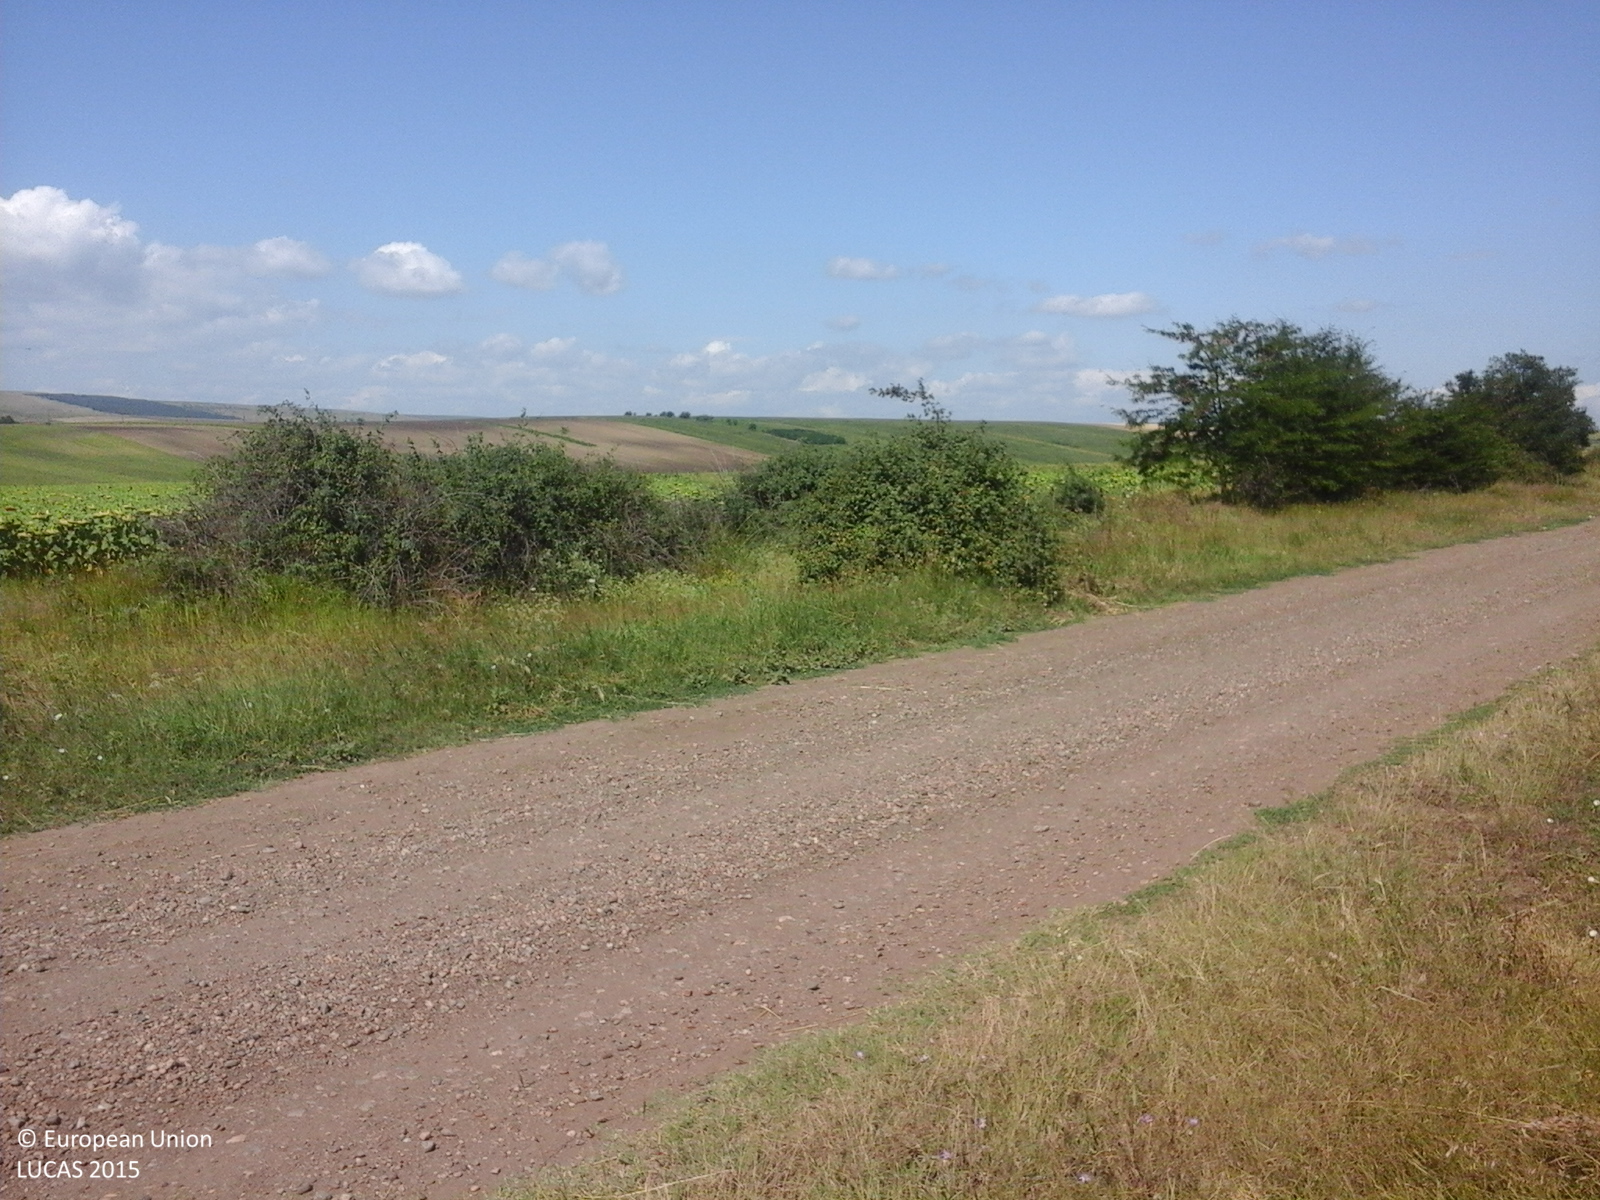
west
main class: Cropland
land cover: Sunflower
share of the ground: > 75 %
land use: Agriculture (excluding fallow land and kitchen gardens)
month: July
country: RO
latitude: 46.4096
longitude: 28.1206
